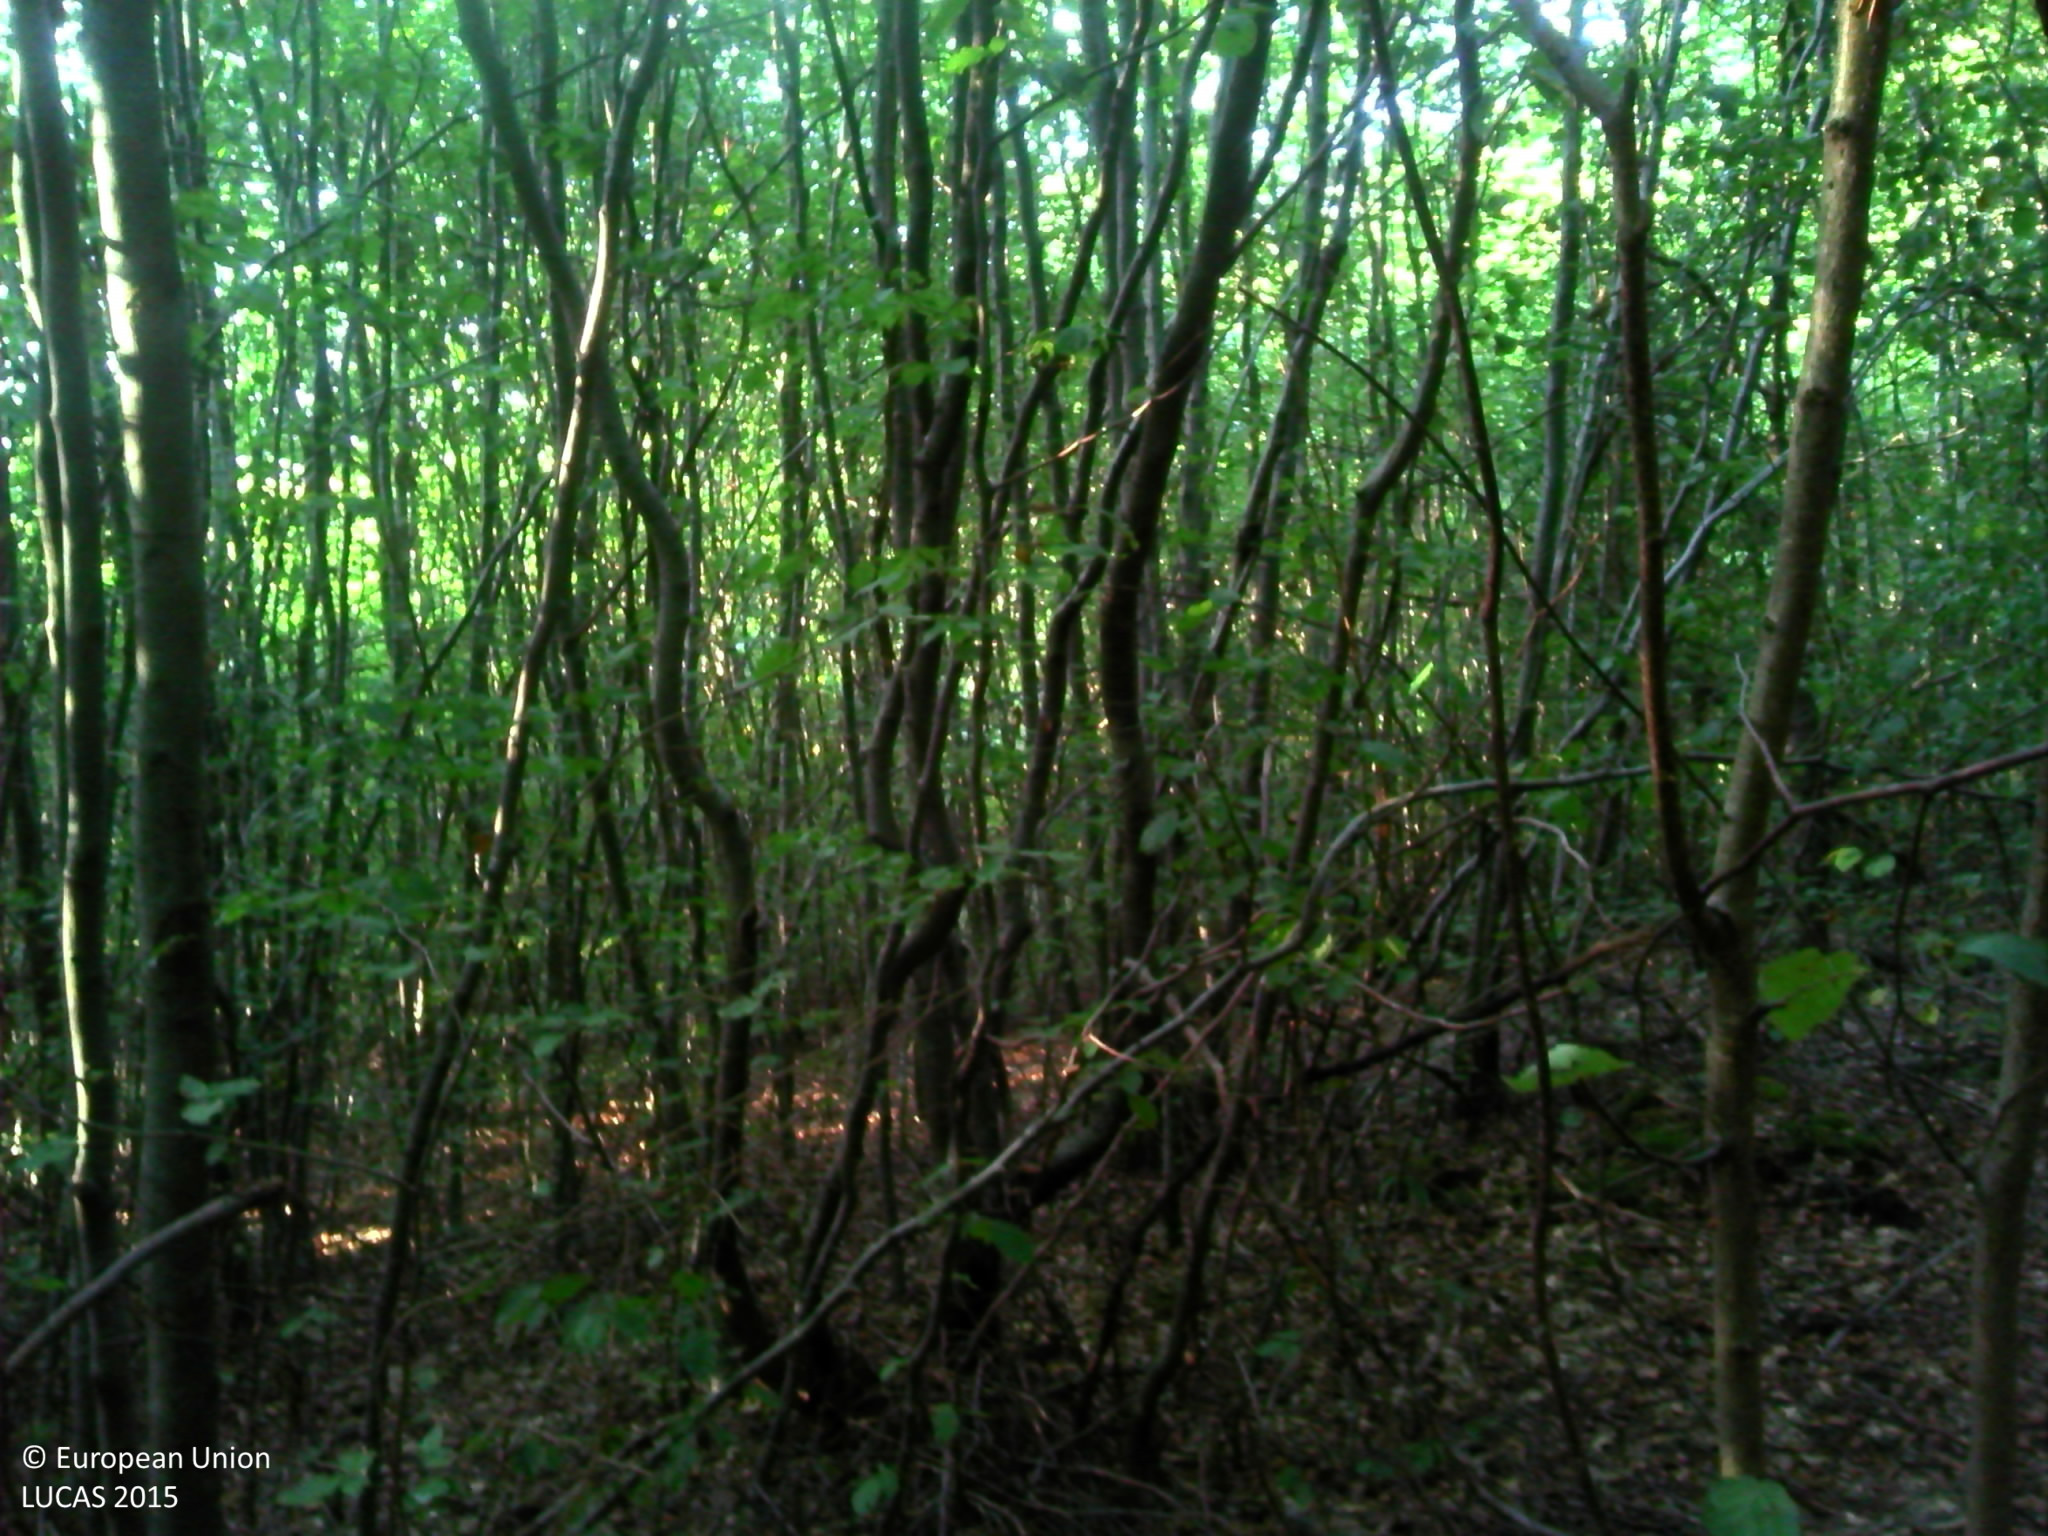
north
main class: Woodland
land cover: Broadleaved woodland
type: beech forest
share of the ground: > 75 %
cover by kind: broadleaved forest trees 100 %
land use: Forestry
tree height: > 5 m
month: September
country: FR
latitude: 47.4692
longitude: 6.6185
